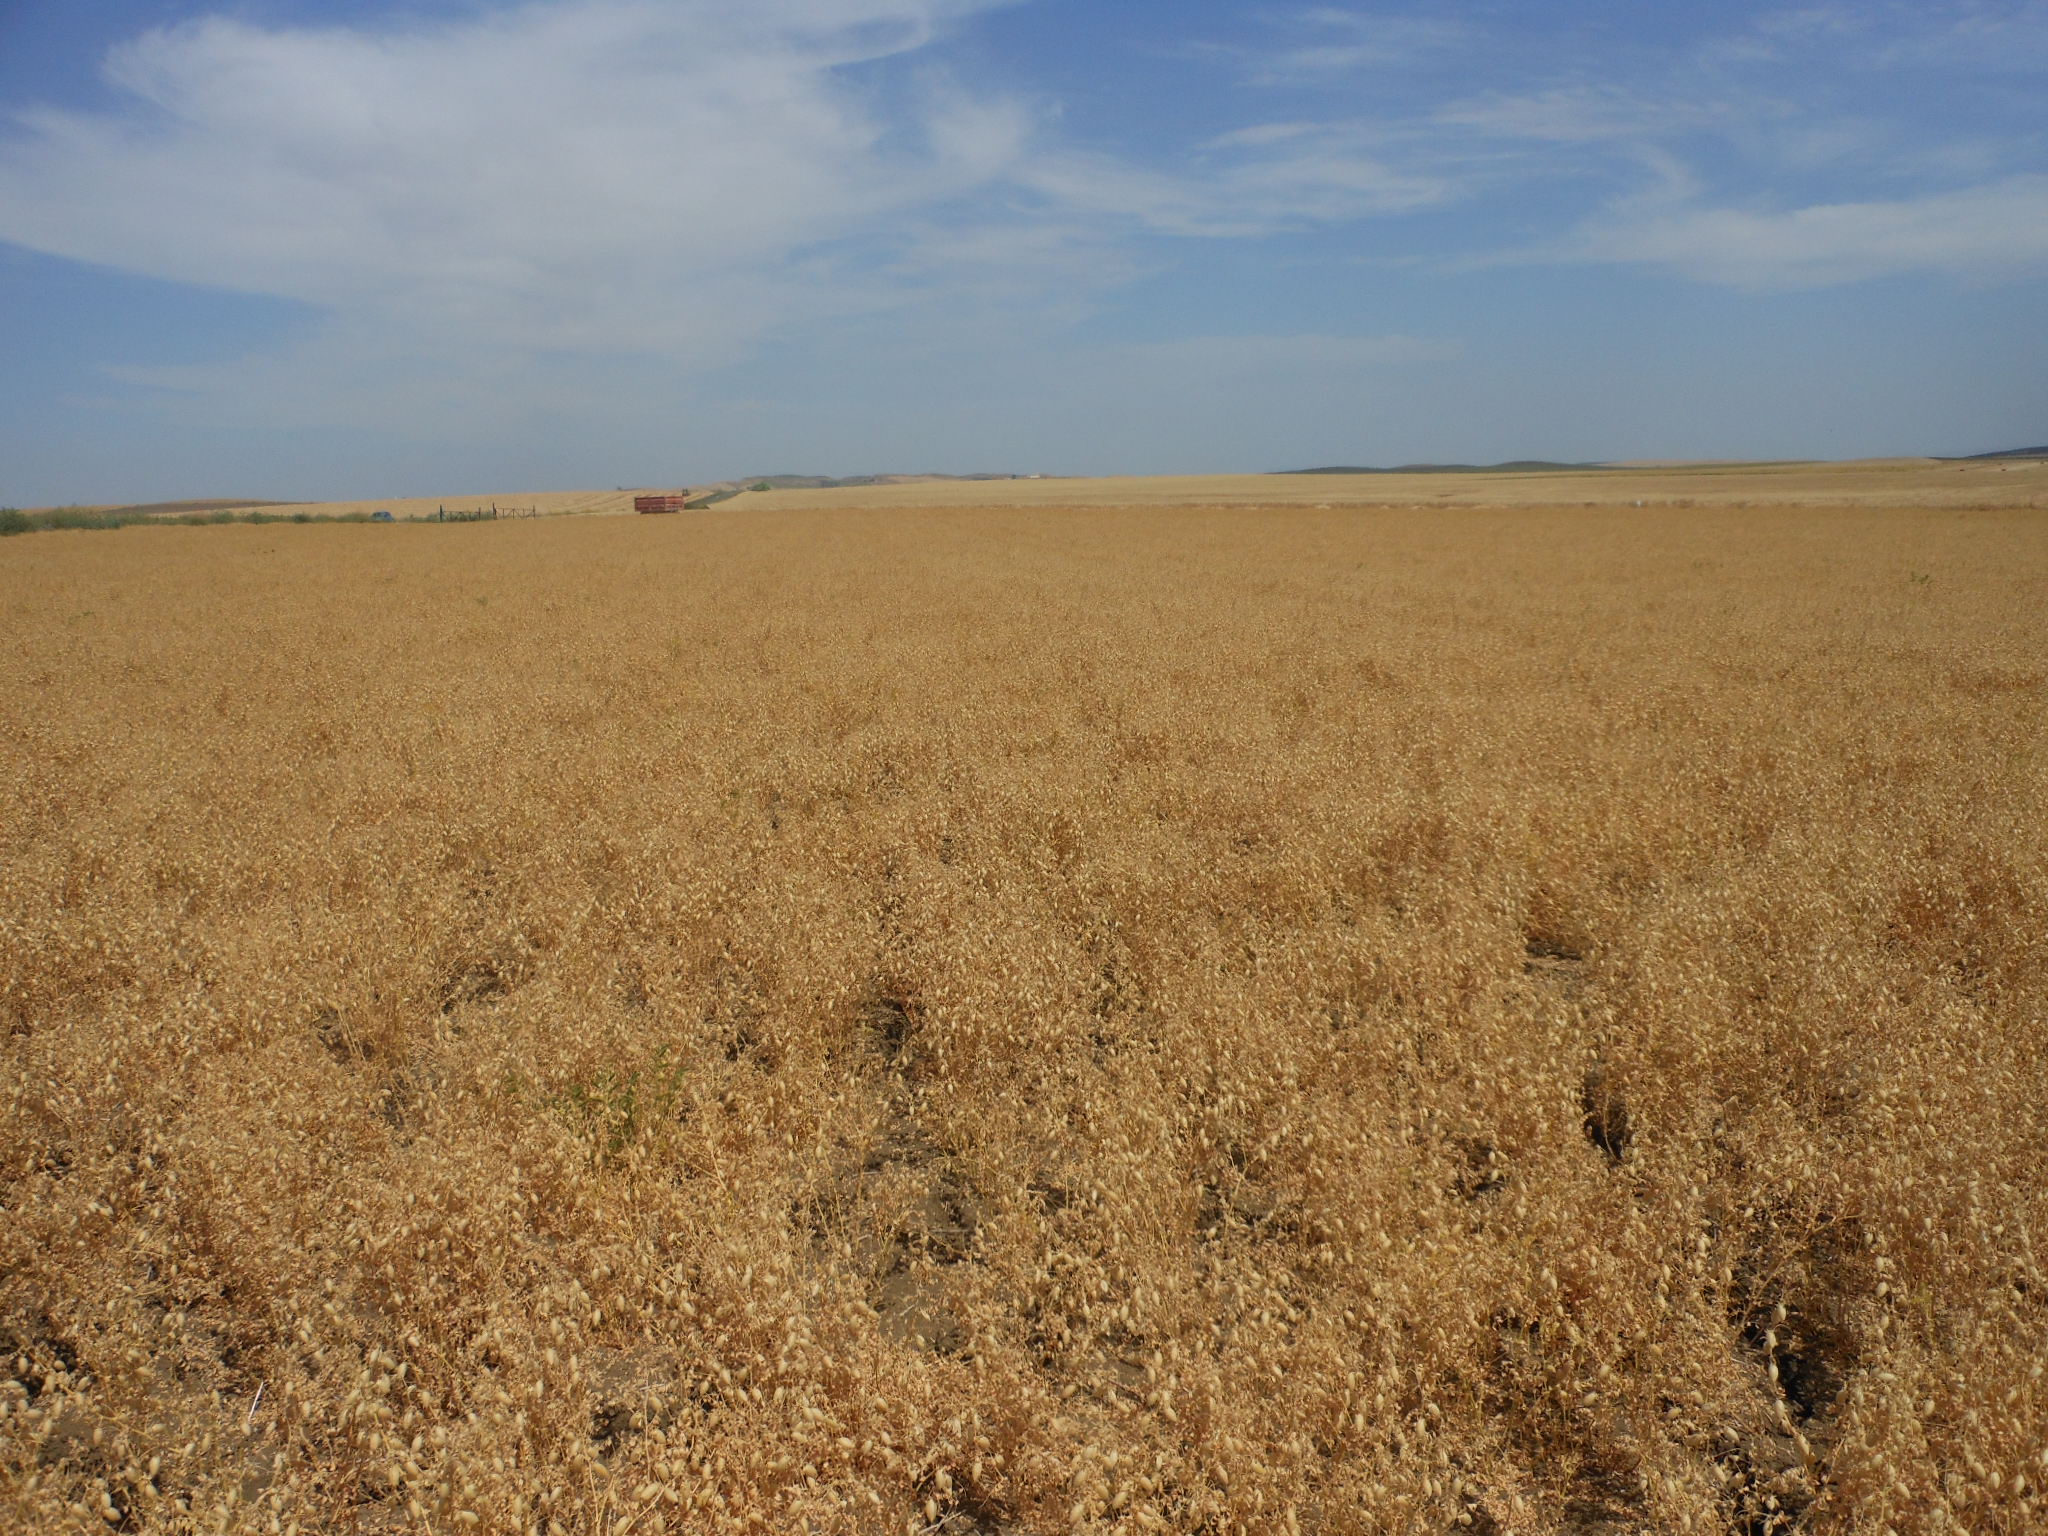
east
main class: Cropland
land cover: Dry pulses
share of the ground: 50 - 75 %
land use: Agriculture (excluding fallow land and kitchen gardens)
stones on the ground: 10 - 25 %
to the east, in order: Dry pulses; Tracks; Common wheat
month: May
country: ES
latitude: 37.4460
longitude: -5.4912
